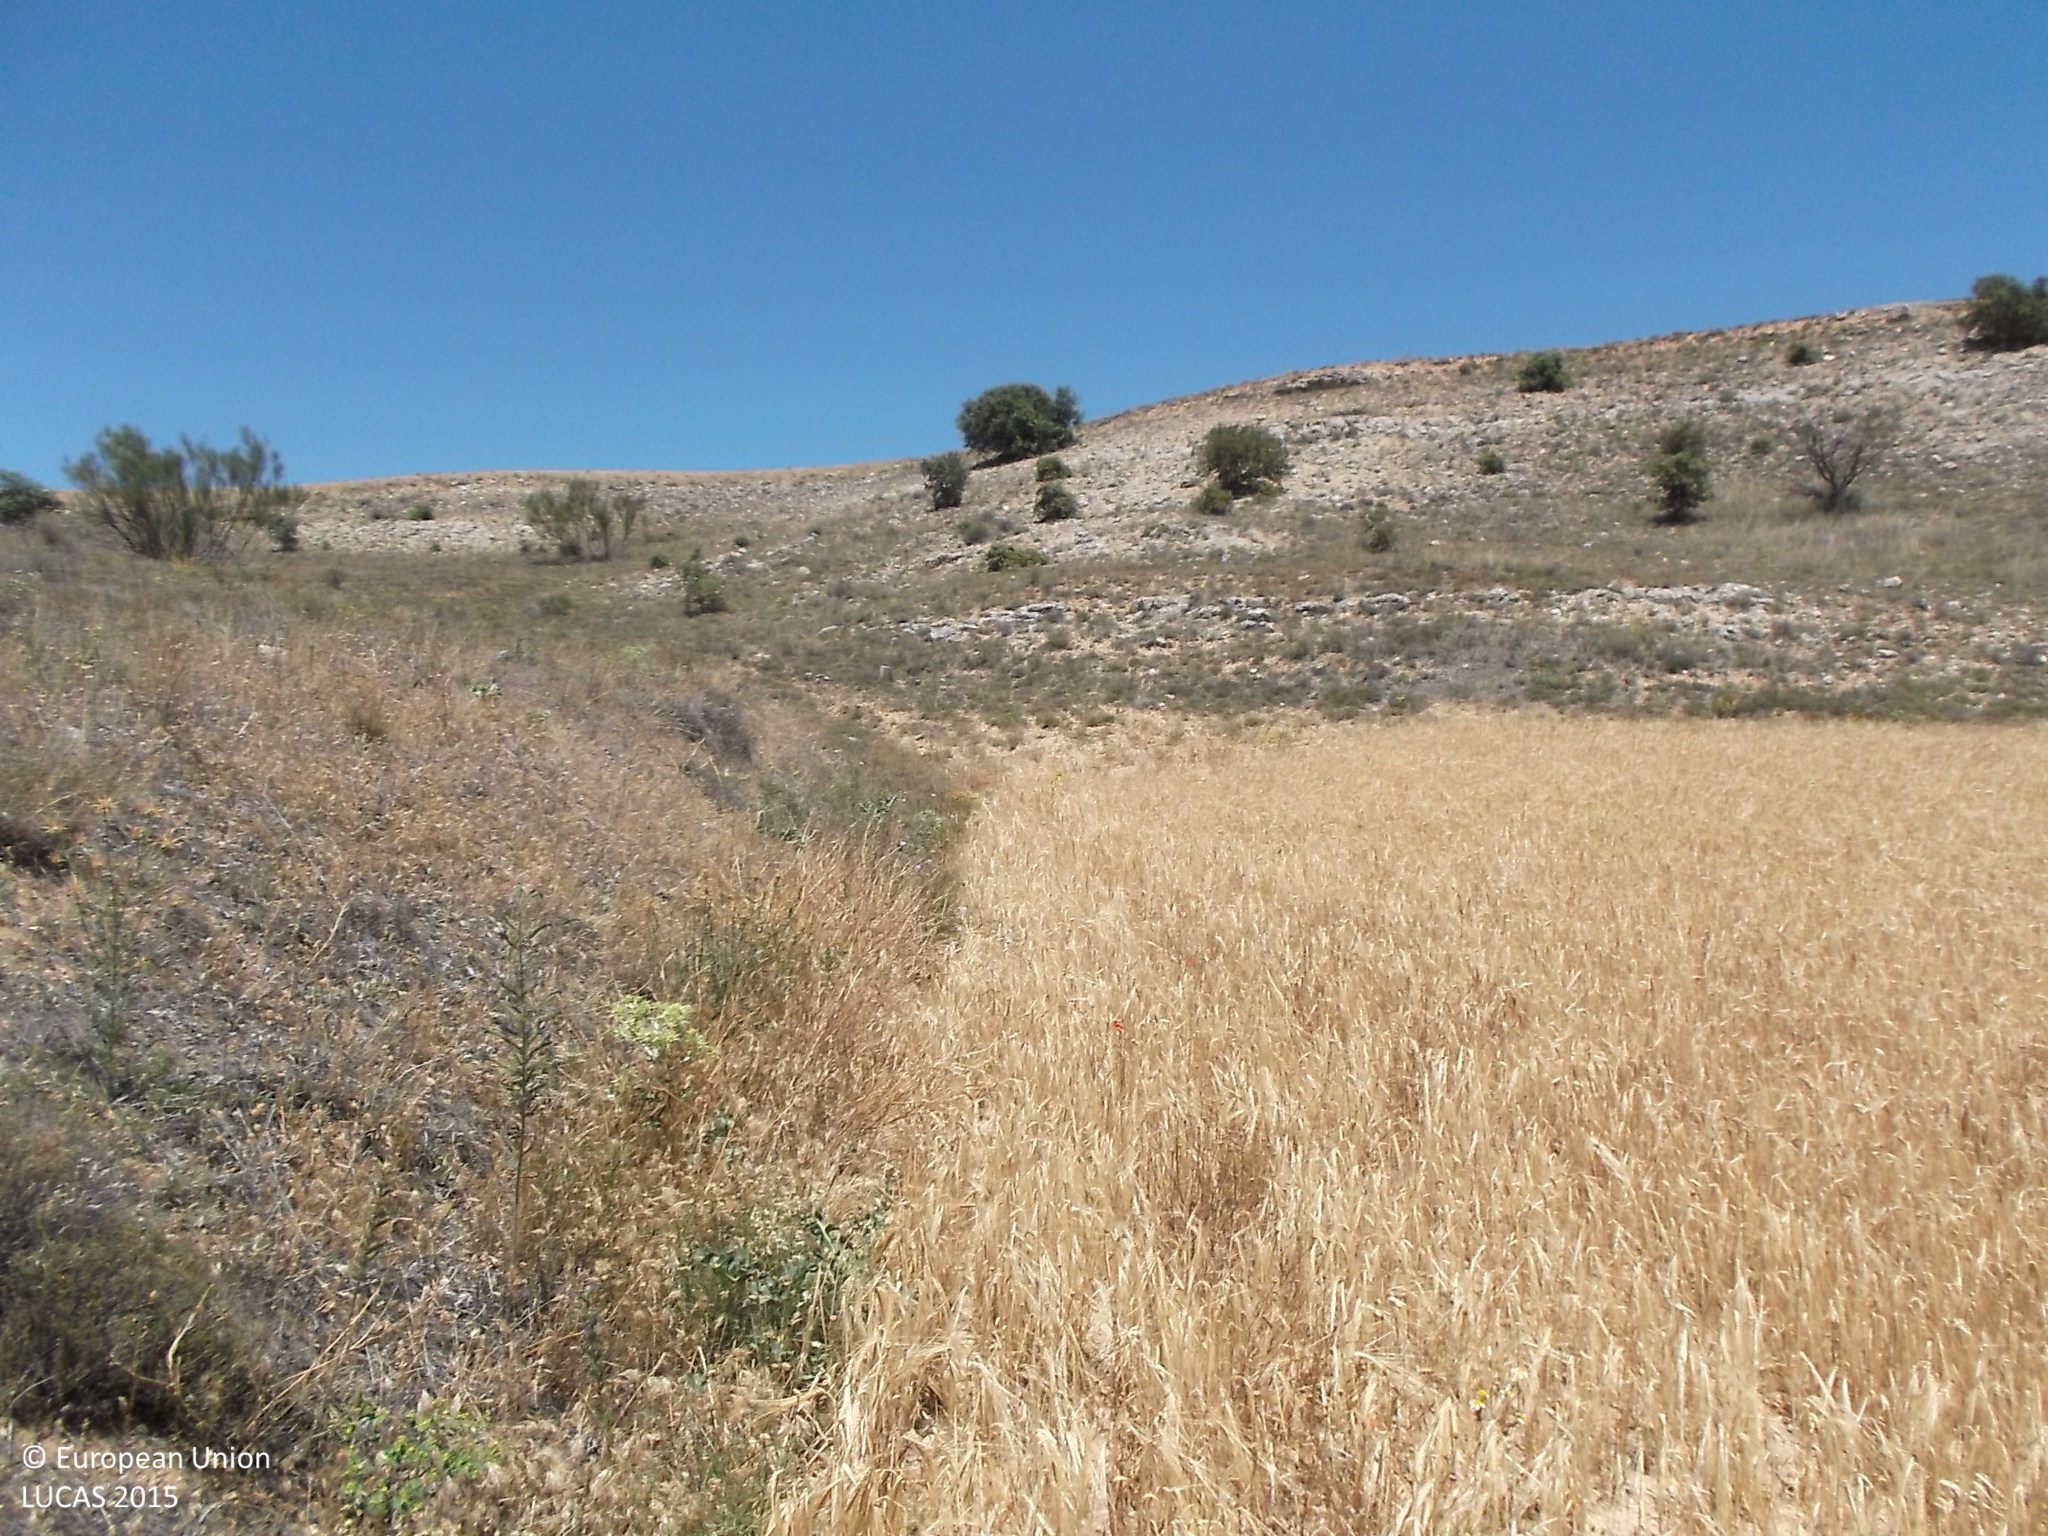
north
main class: Cropland
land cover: Barley
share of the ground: > 75 %
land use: Agriculture (excluding fallow land and kitchen gardens)
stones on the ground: < 10 %
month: June
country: ES
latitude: 41.3632
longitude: -5.3666
